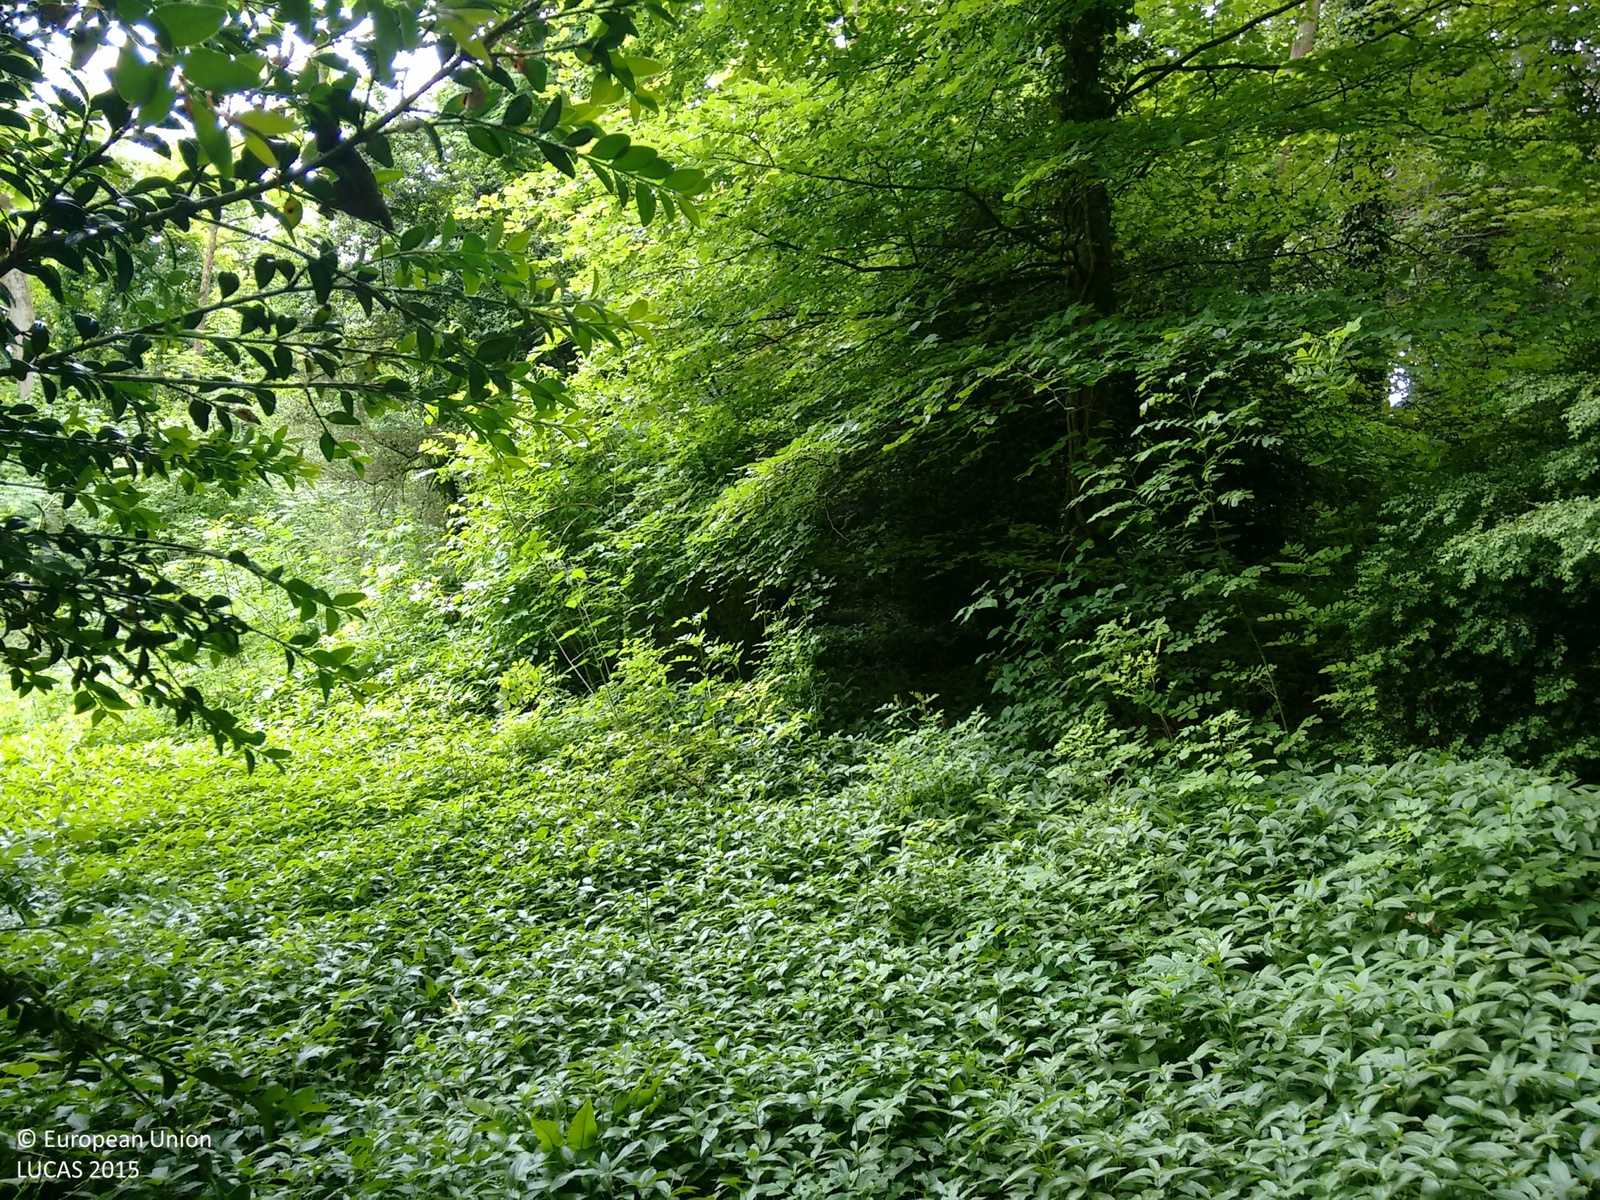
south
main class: Woodland
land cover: Broadleaved woodland
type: beech forest
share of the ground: > 75 %
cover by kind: broadleaved forest trees 95 %, herbaceous plants 5 %
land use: Semi-natural and natural areas not in use
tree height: > 5 m
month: May
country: GB
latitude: 50.8563
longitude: -2.1785
